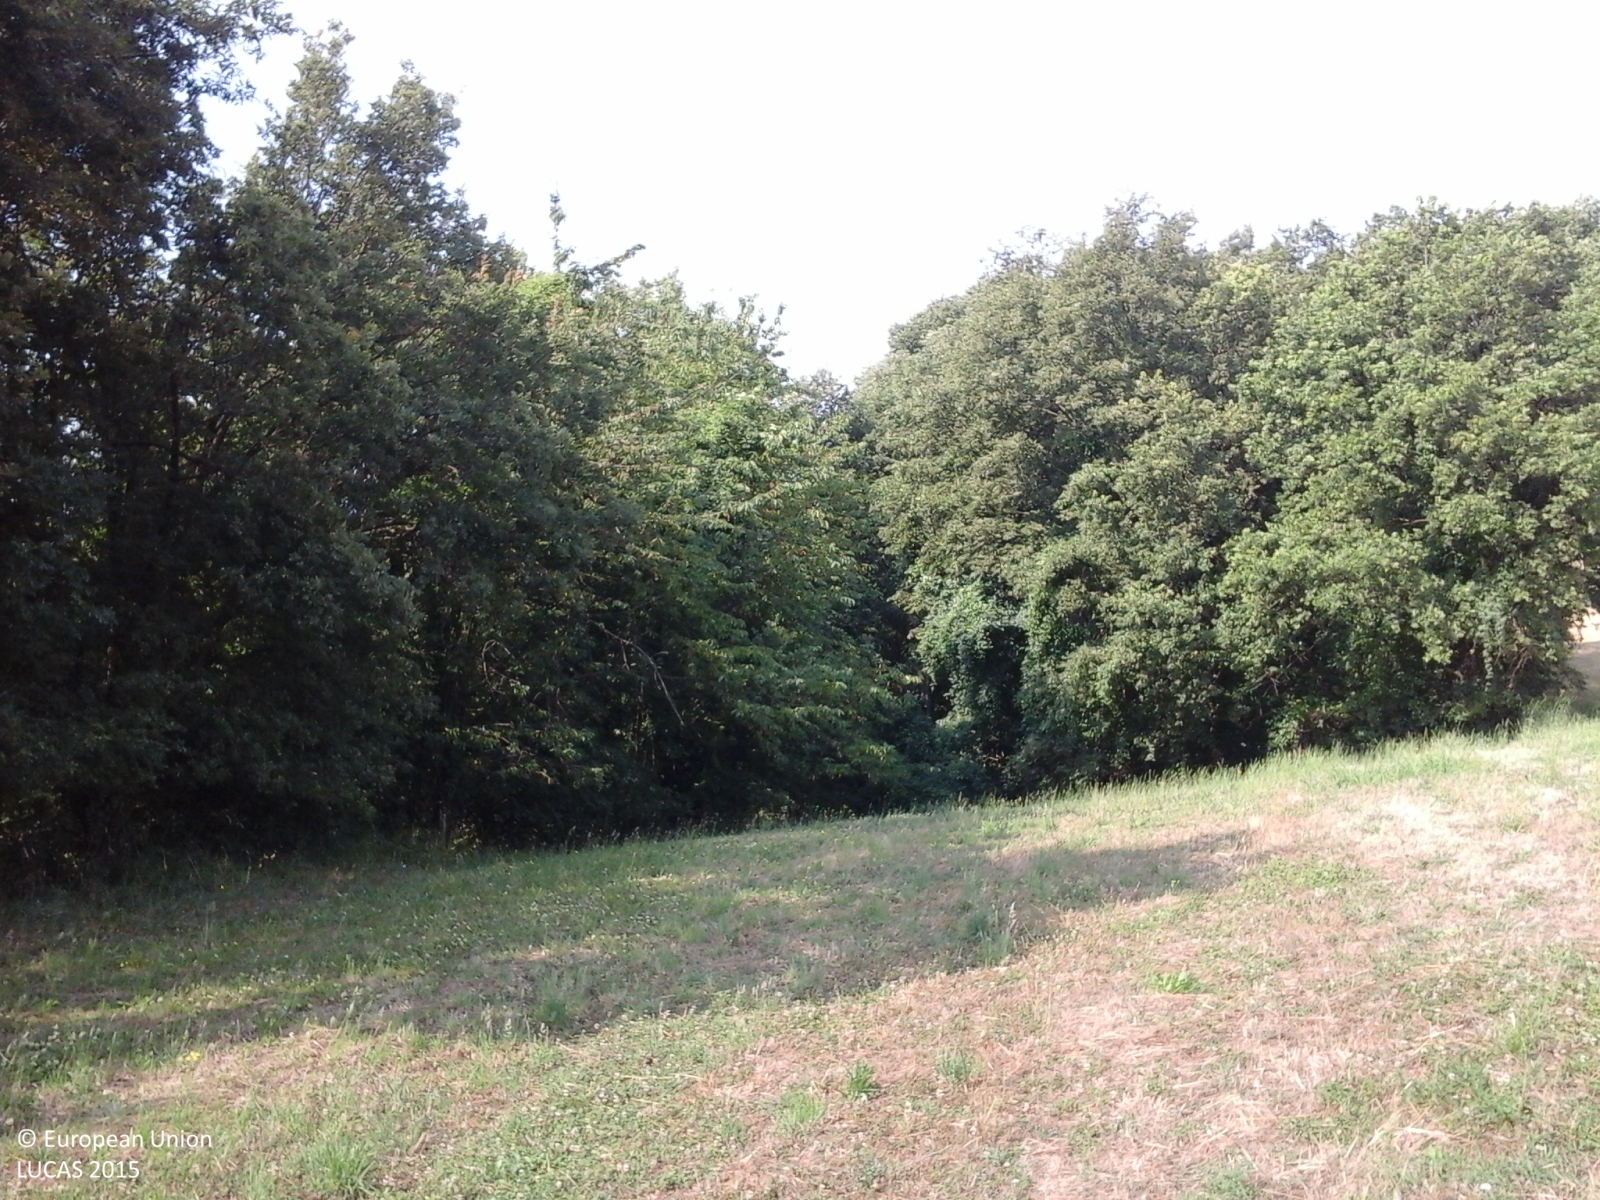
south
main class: Grassland
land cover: Grassland without tree/shrub cover
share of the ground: > 75 %
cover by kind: herbaceous plants 100 %
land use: Agriculture (excluding fallow land and kitchen gardens)
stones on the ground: 10 - 25 %
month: June
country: IT
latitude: 44.7291
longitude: 10.1890
